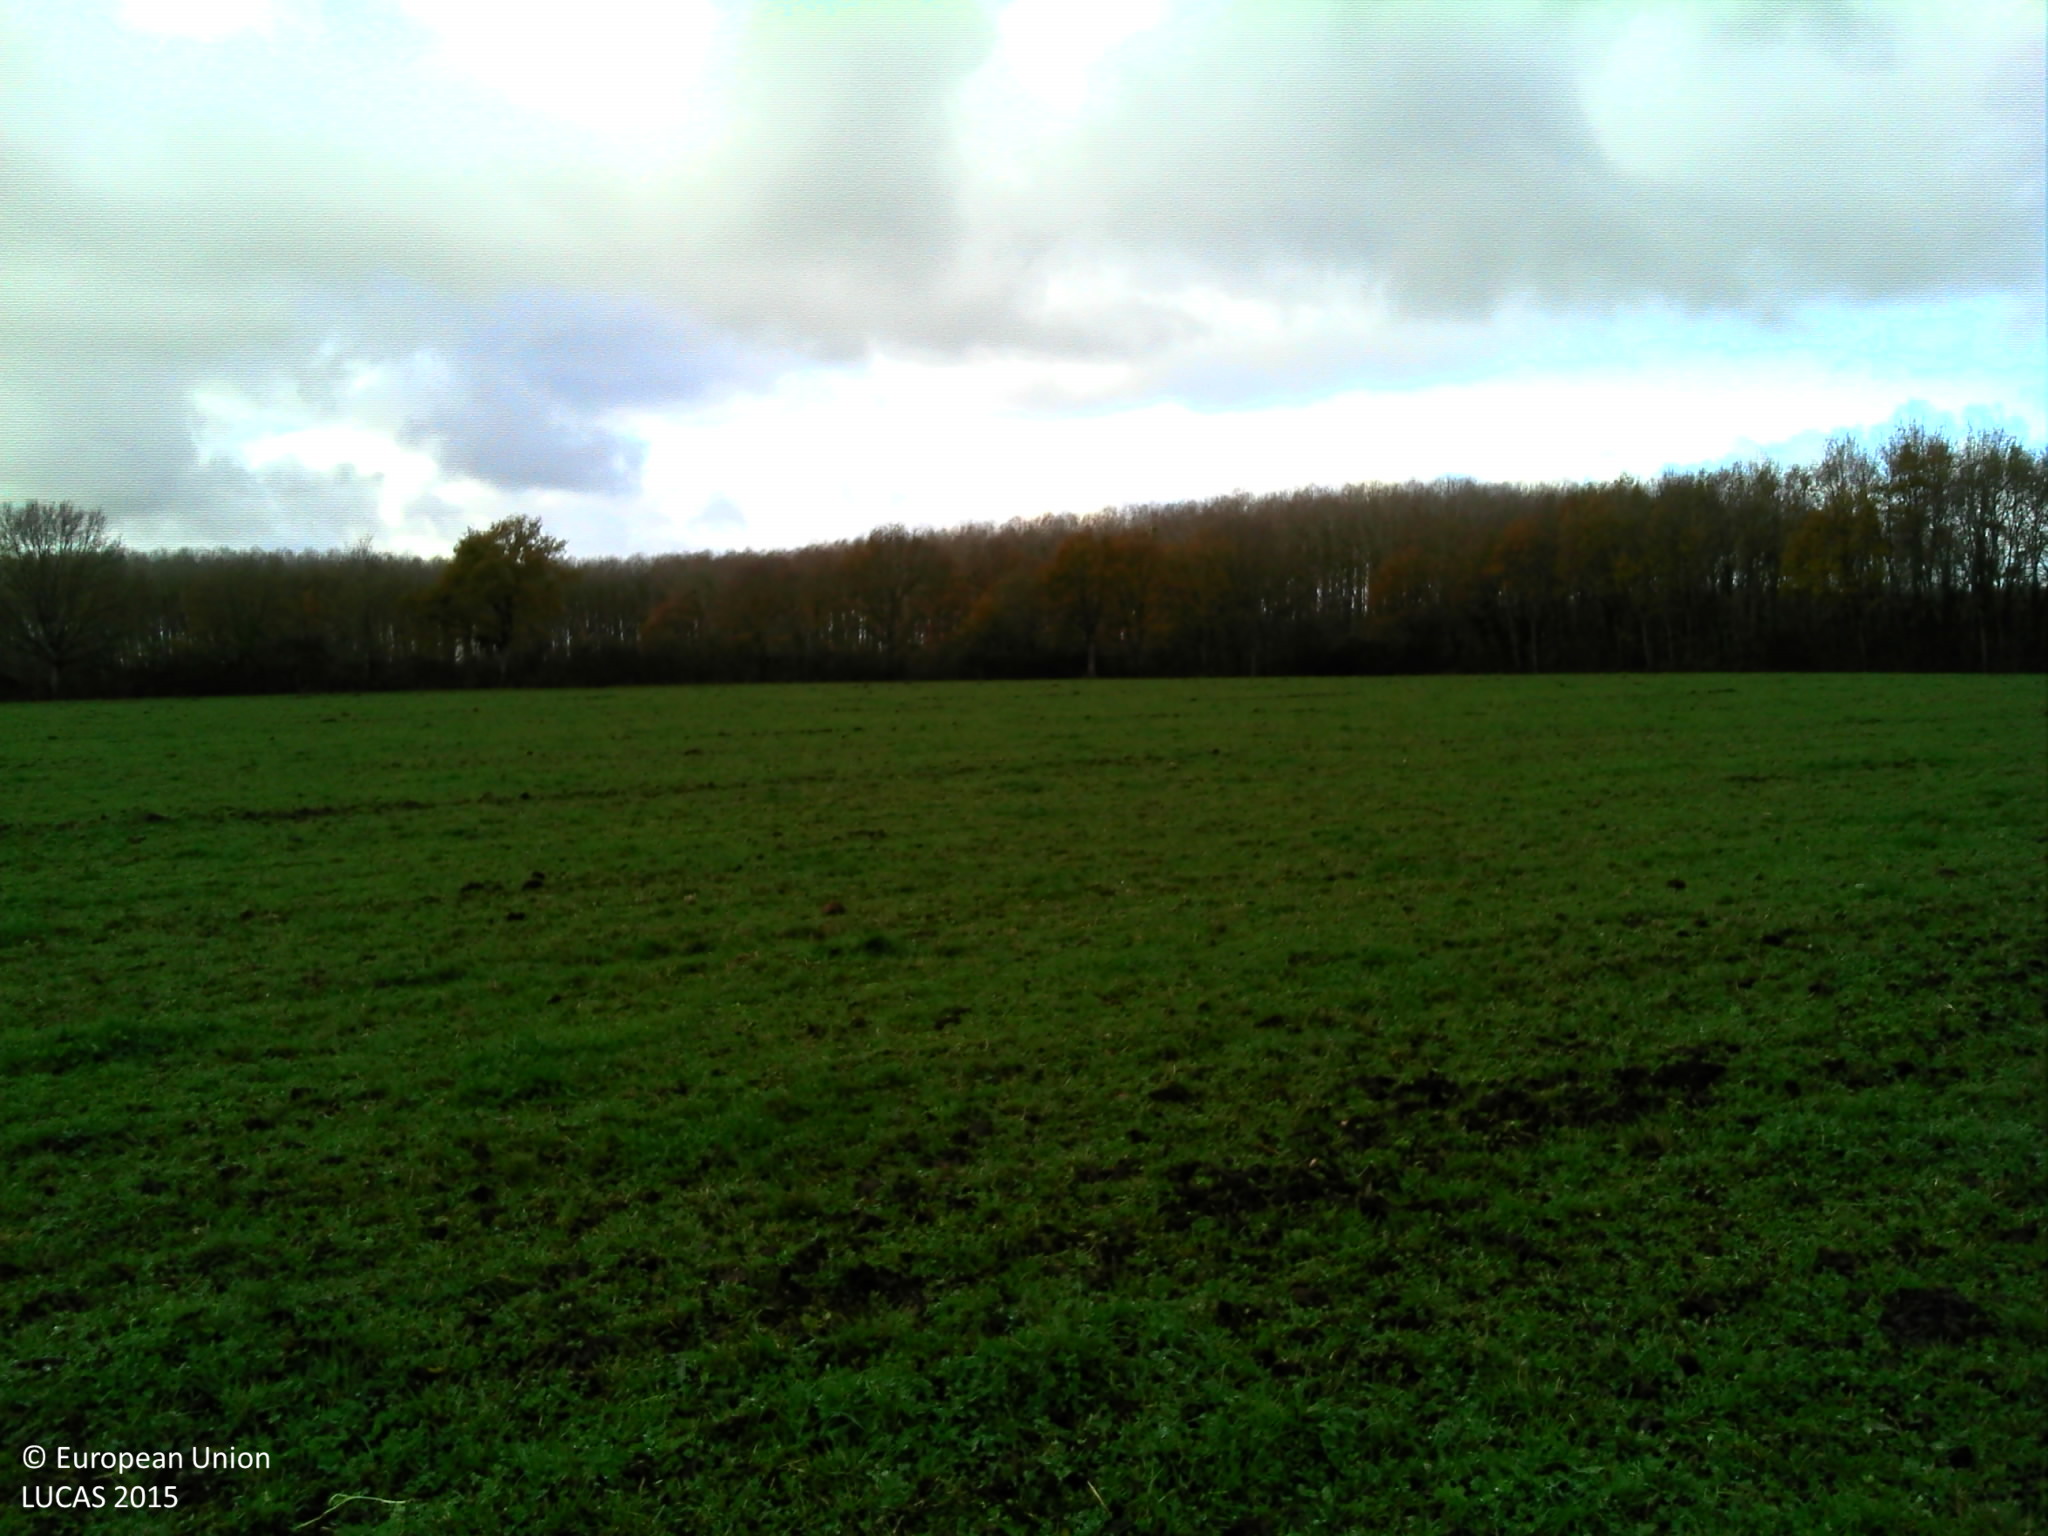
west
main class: Grassland
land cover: Grassland without tree/shrub cover
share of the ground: > 75 %
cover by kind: herbaceous plants 100 %
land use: Agriculture (excluding fallow land and kitchen gardens)
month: August
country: FR
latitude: 46.4310
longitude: 3.6096
